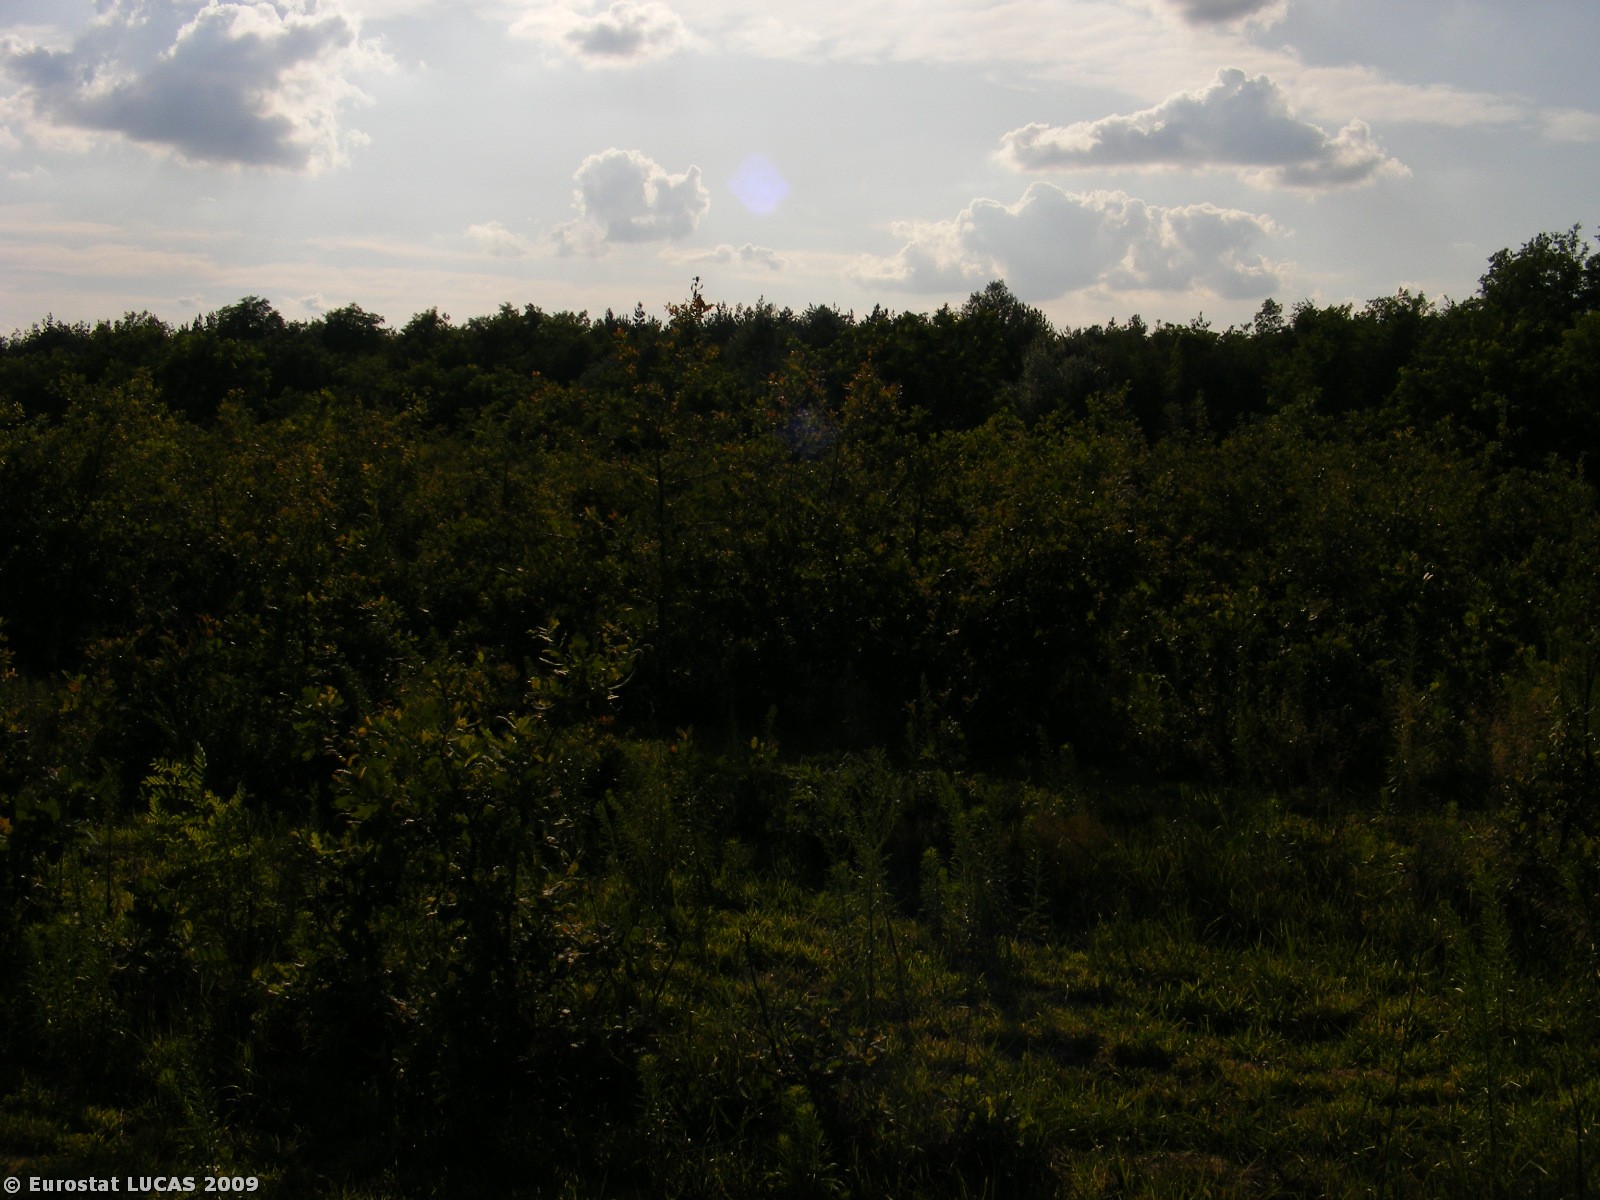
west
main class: Shrubland
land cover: Shrubland with sparse tree cover
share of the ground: 25 - 50 %
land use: Forestry
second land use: Nature reserves
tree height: < 5 m
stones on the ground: < 10 %
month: July
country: HU
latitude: 47.4615
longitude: 21.7864
